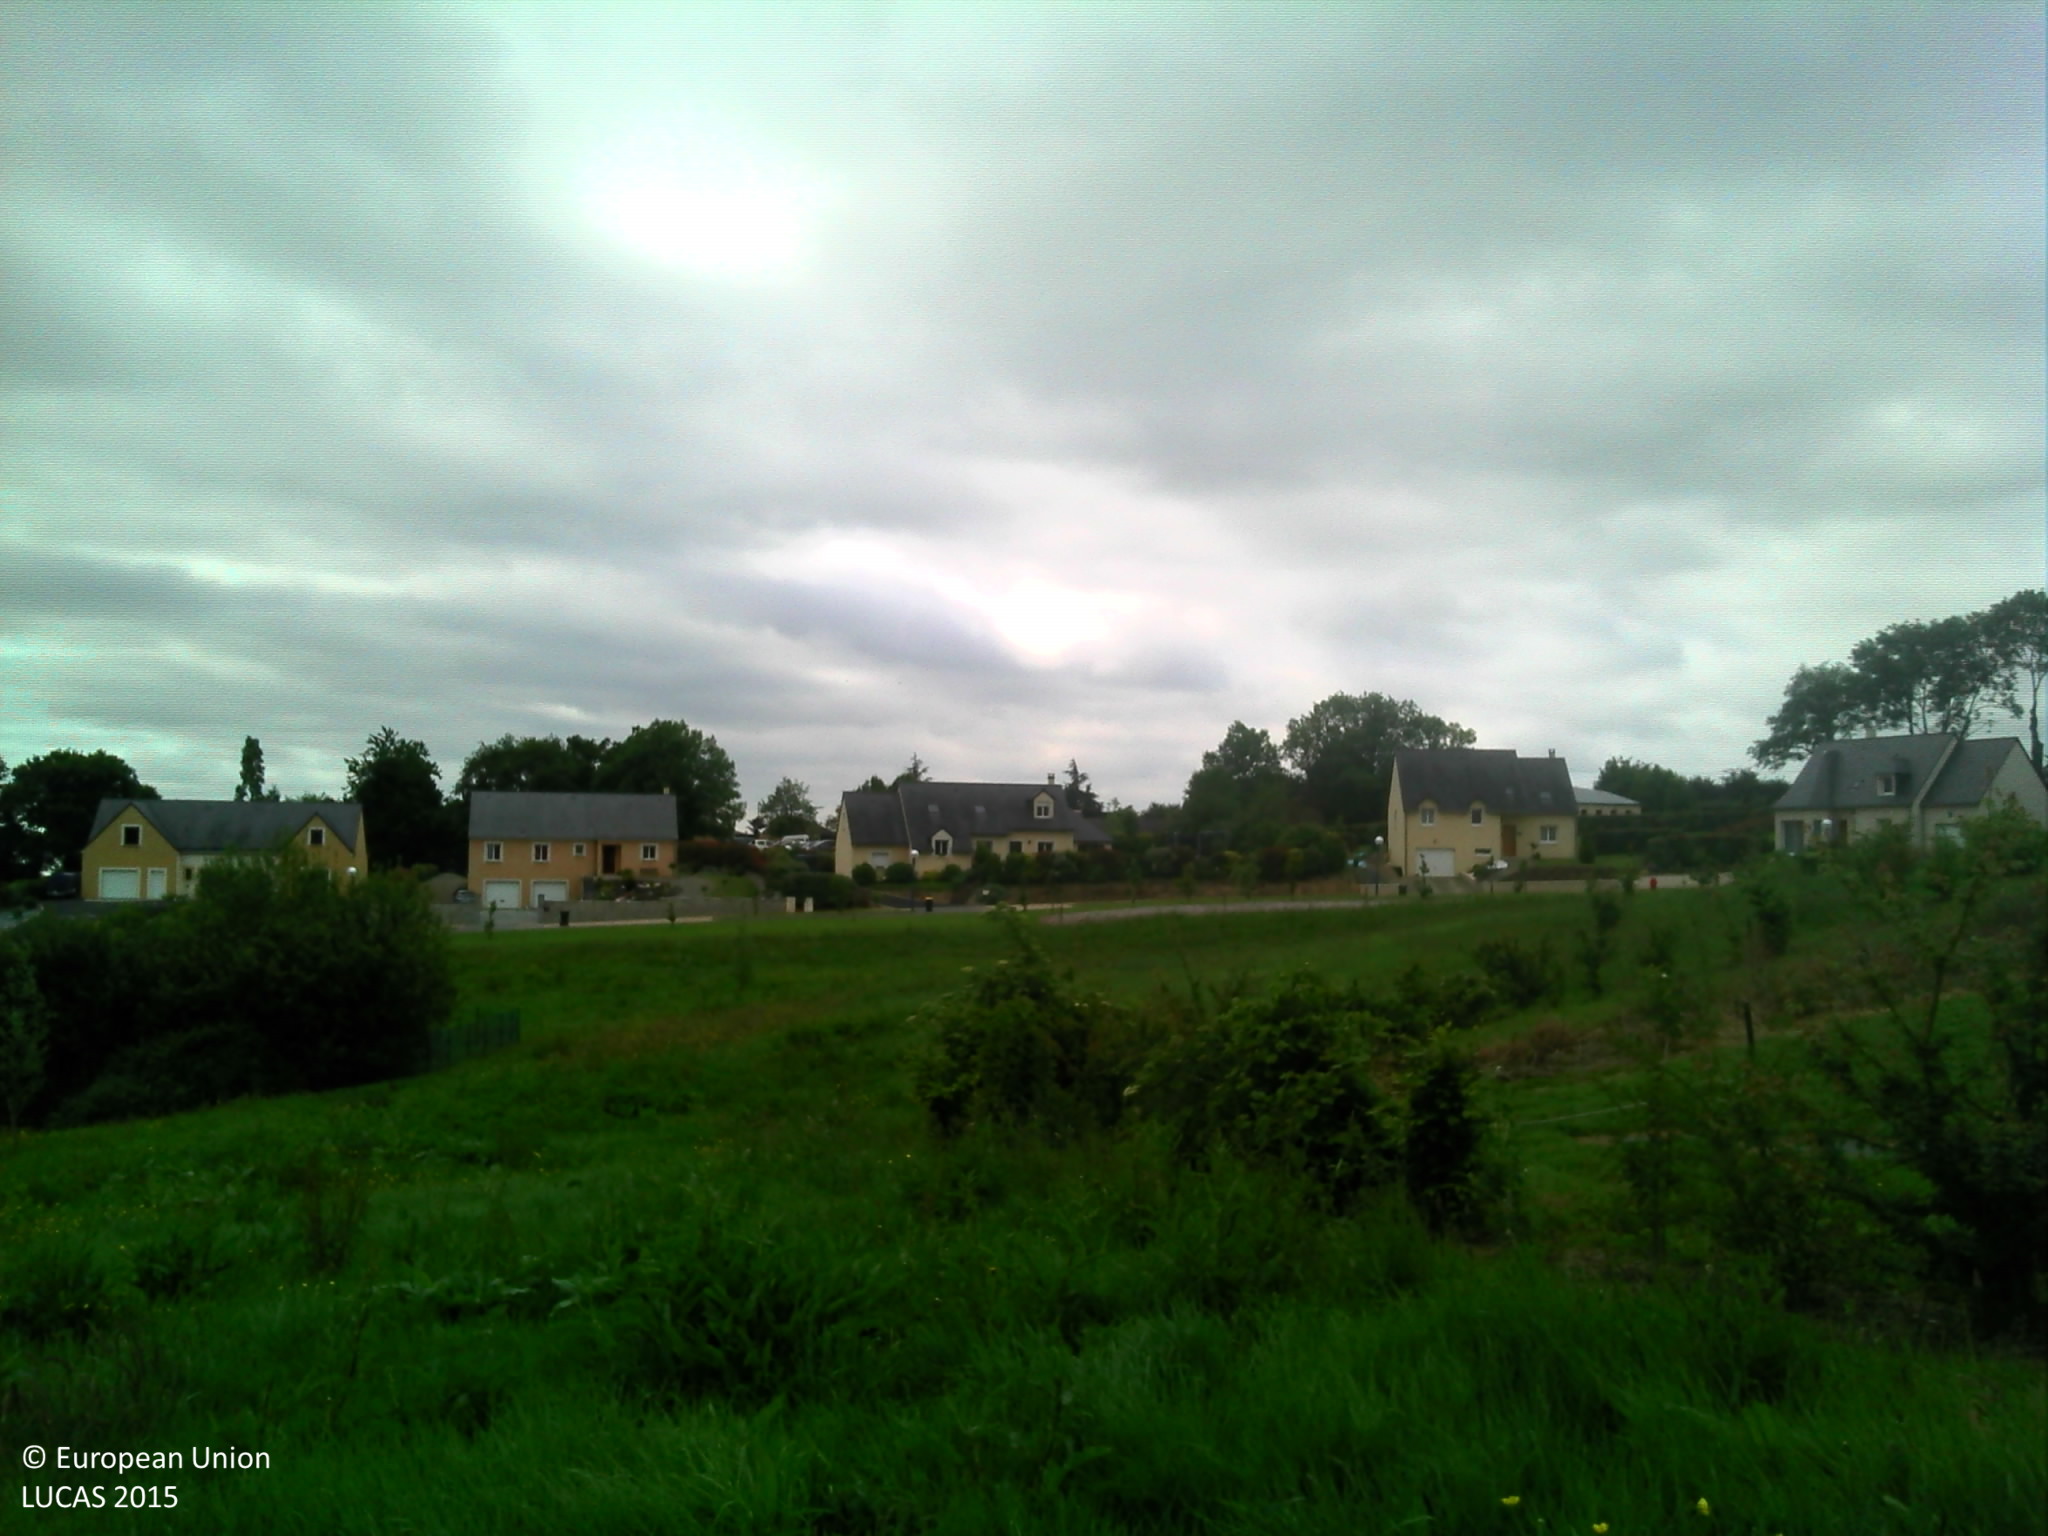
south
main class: Grassland
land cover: Grassland without tree/shrub cover
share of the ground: > 75 %
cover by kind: herbaceous plants 100 %
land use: Residential
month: May
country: FR
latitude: 48.1907
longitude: -0.1325
